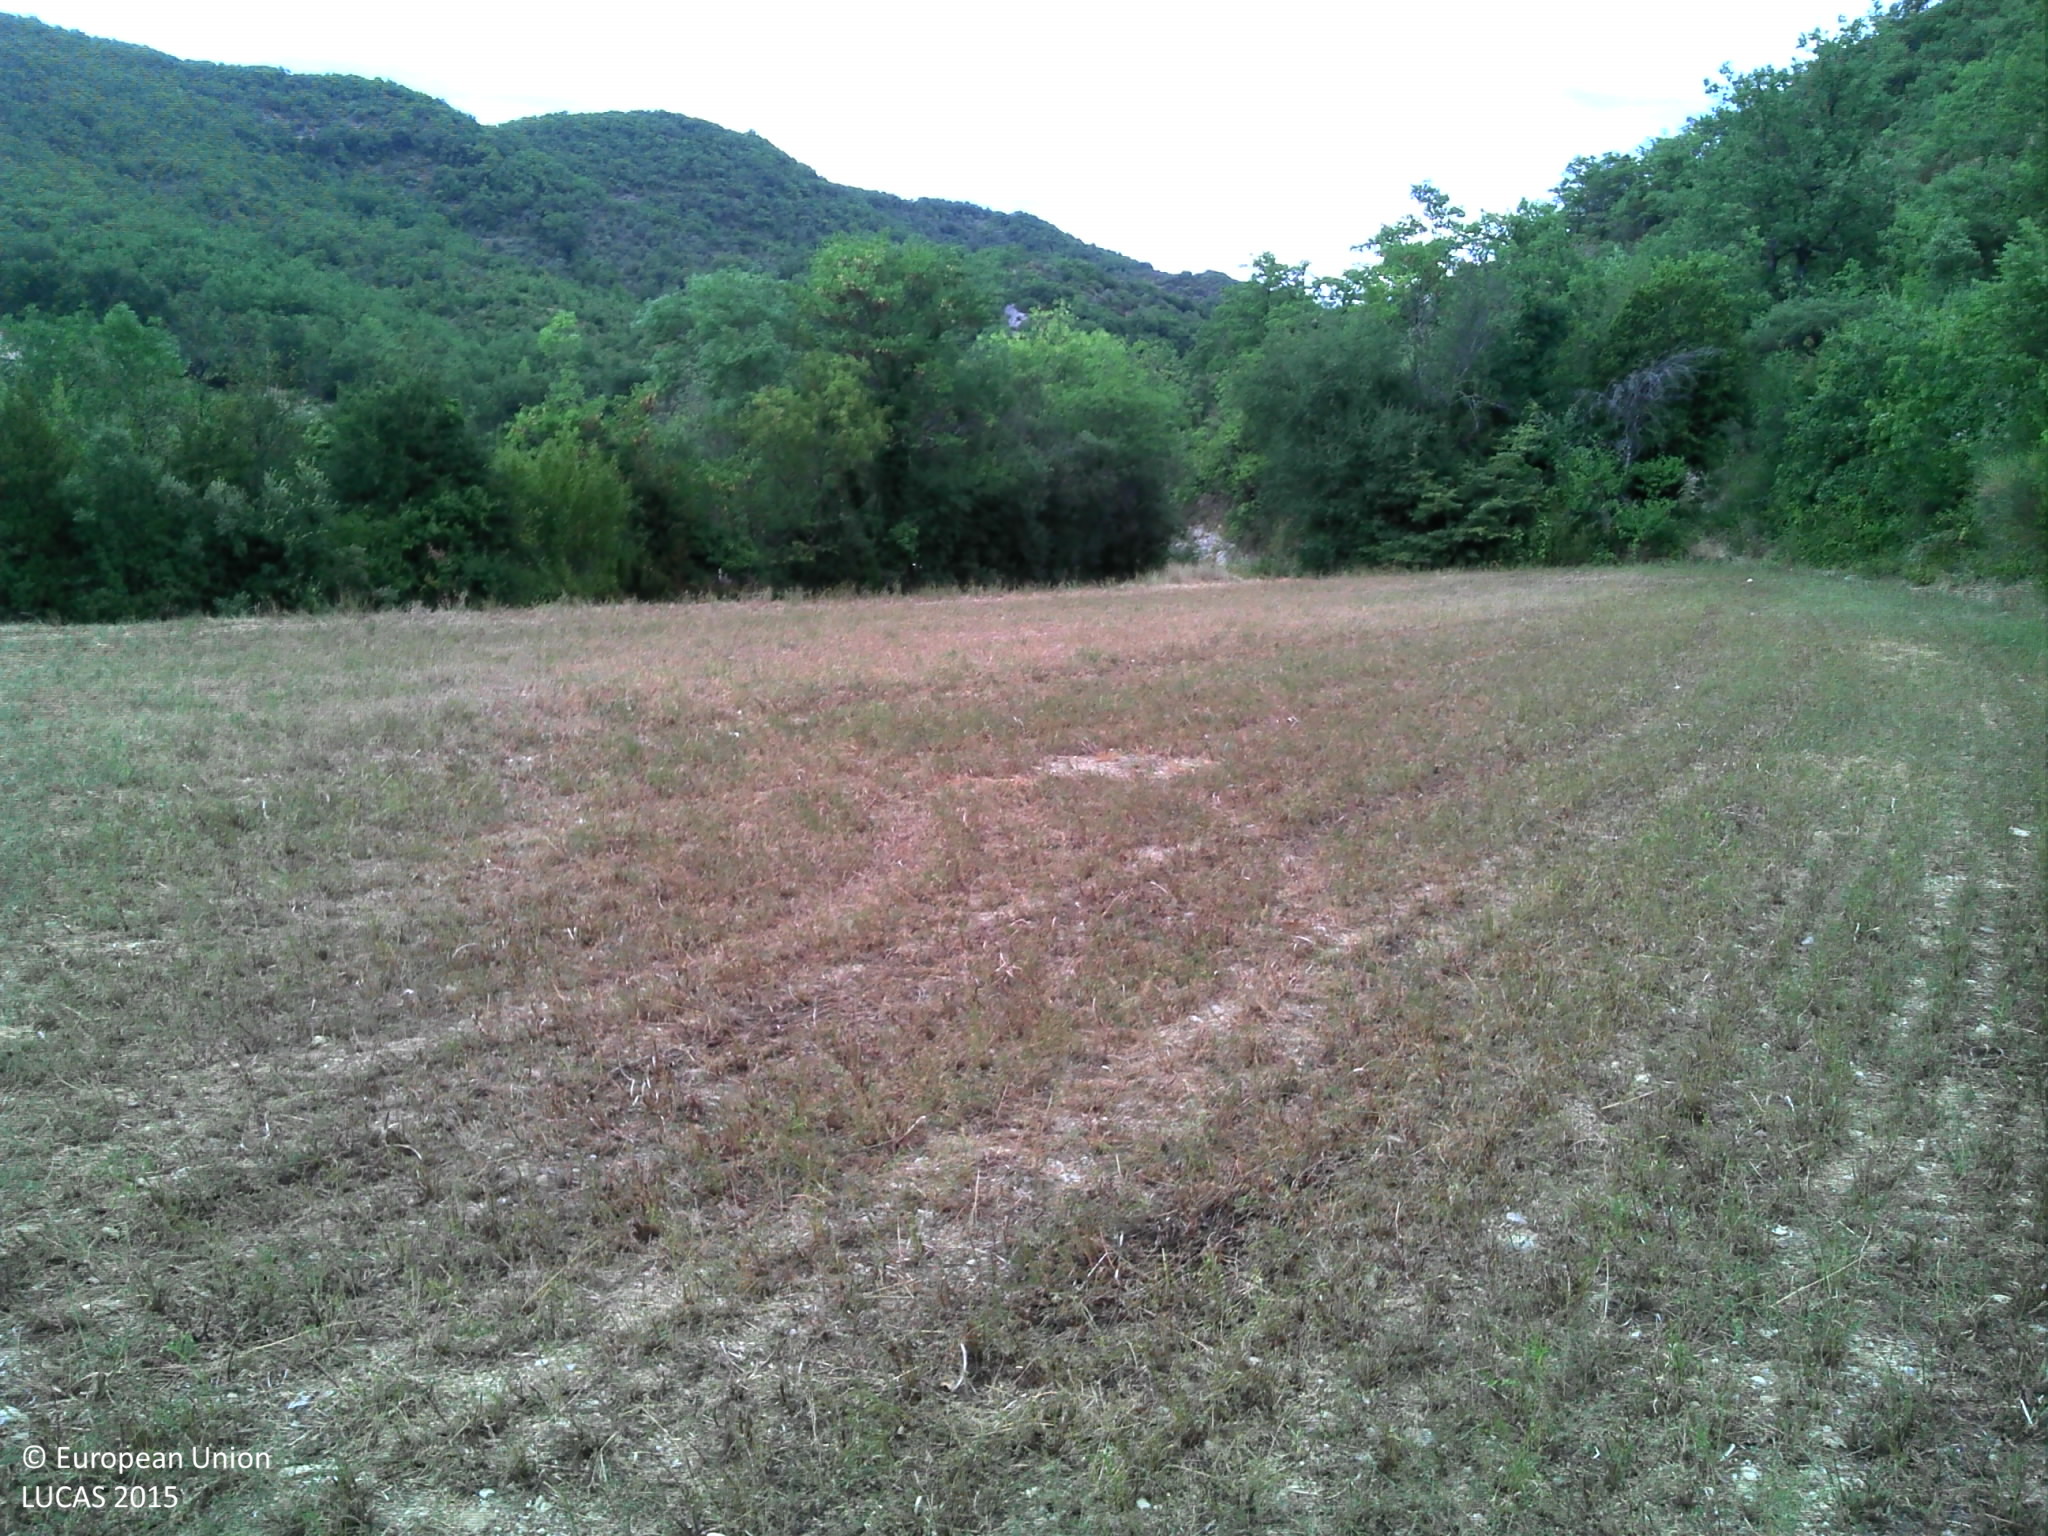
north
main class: Woodland
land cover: Broadleaved woodland
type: broadleaved evergreen forest
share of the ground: > 75 %
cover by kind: broadleaved forest trees 90 %, herbaceous plants 10 %
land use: Semi-natural and natural areas not in use
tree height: > 5 m
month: July
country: FR
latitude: 44.4817
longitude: 4.6130
